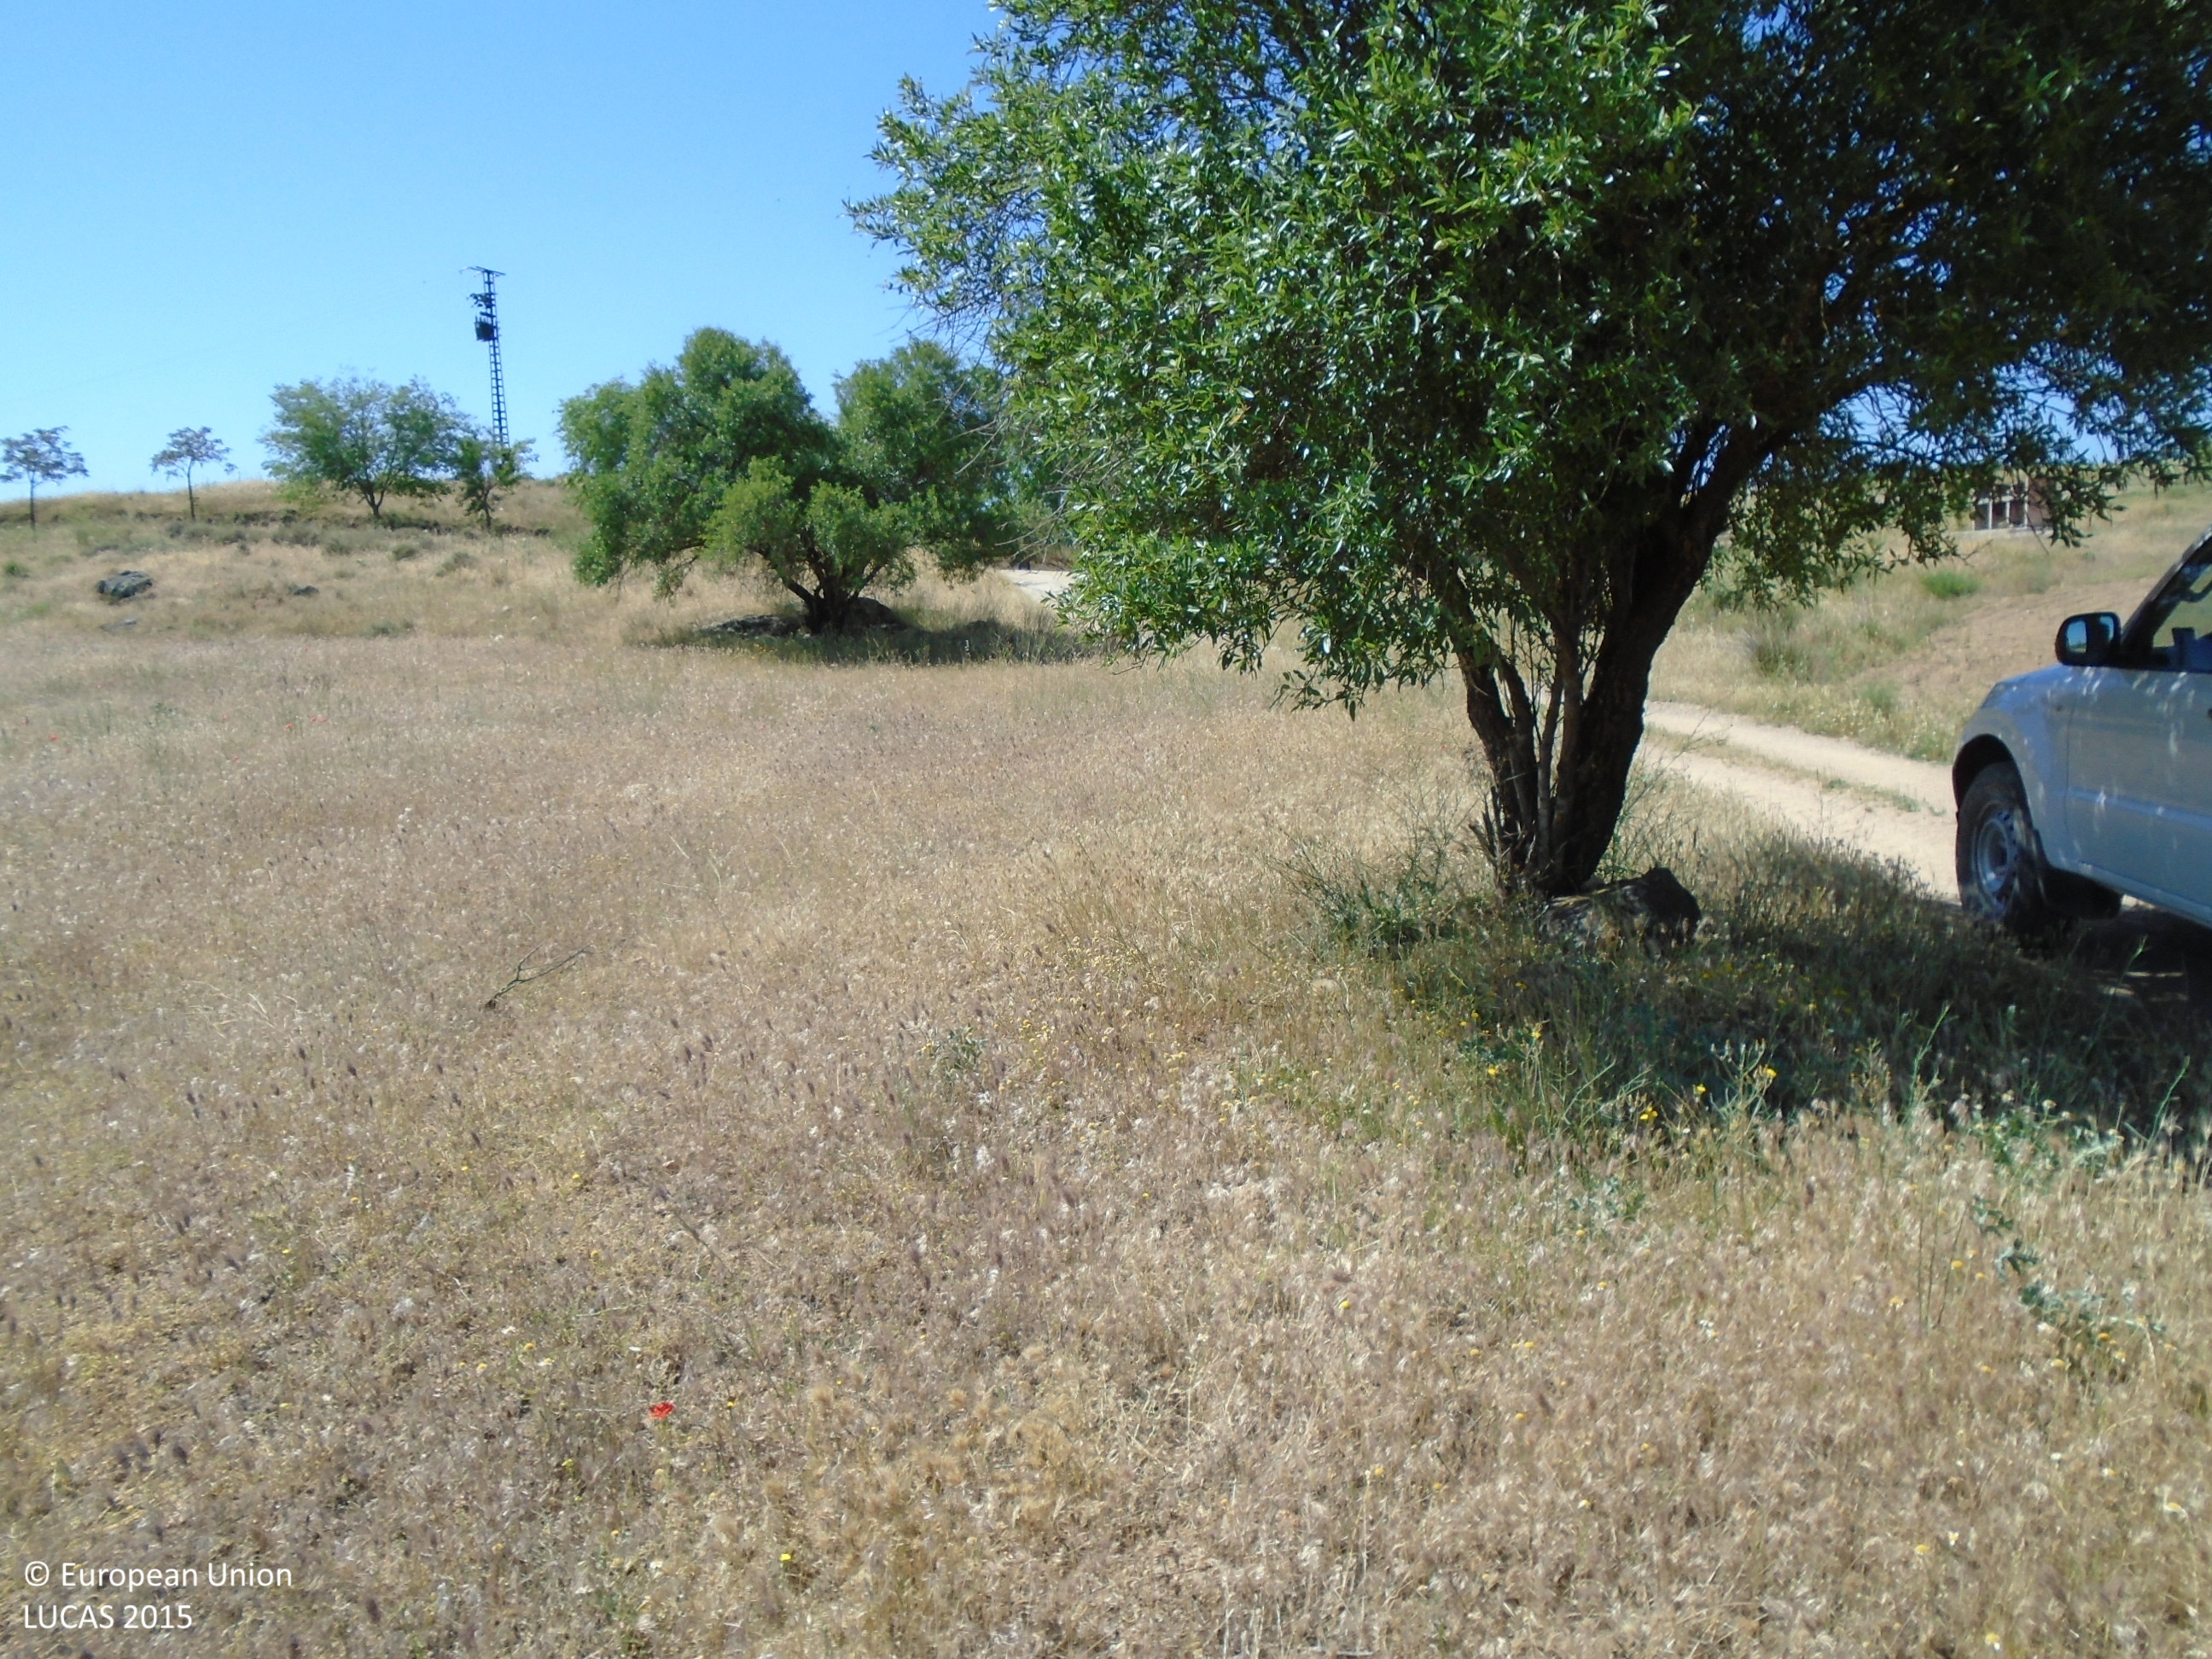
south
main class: Grassland
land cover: Spontaneously vegetated surfaces
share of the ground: > 75 %
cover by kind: herbaceous plants 100 %
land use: Fallow land
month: May
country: ES
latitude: 39.7274
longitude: -3.6666
